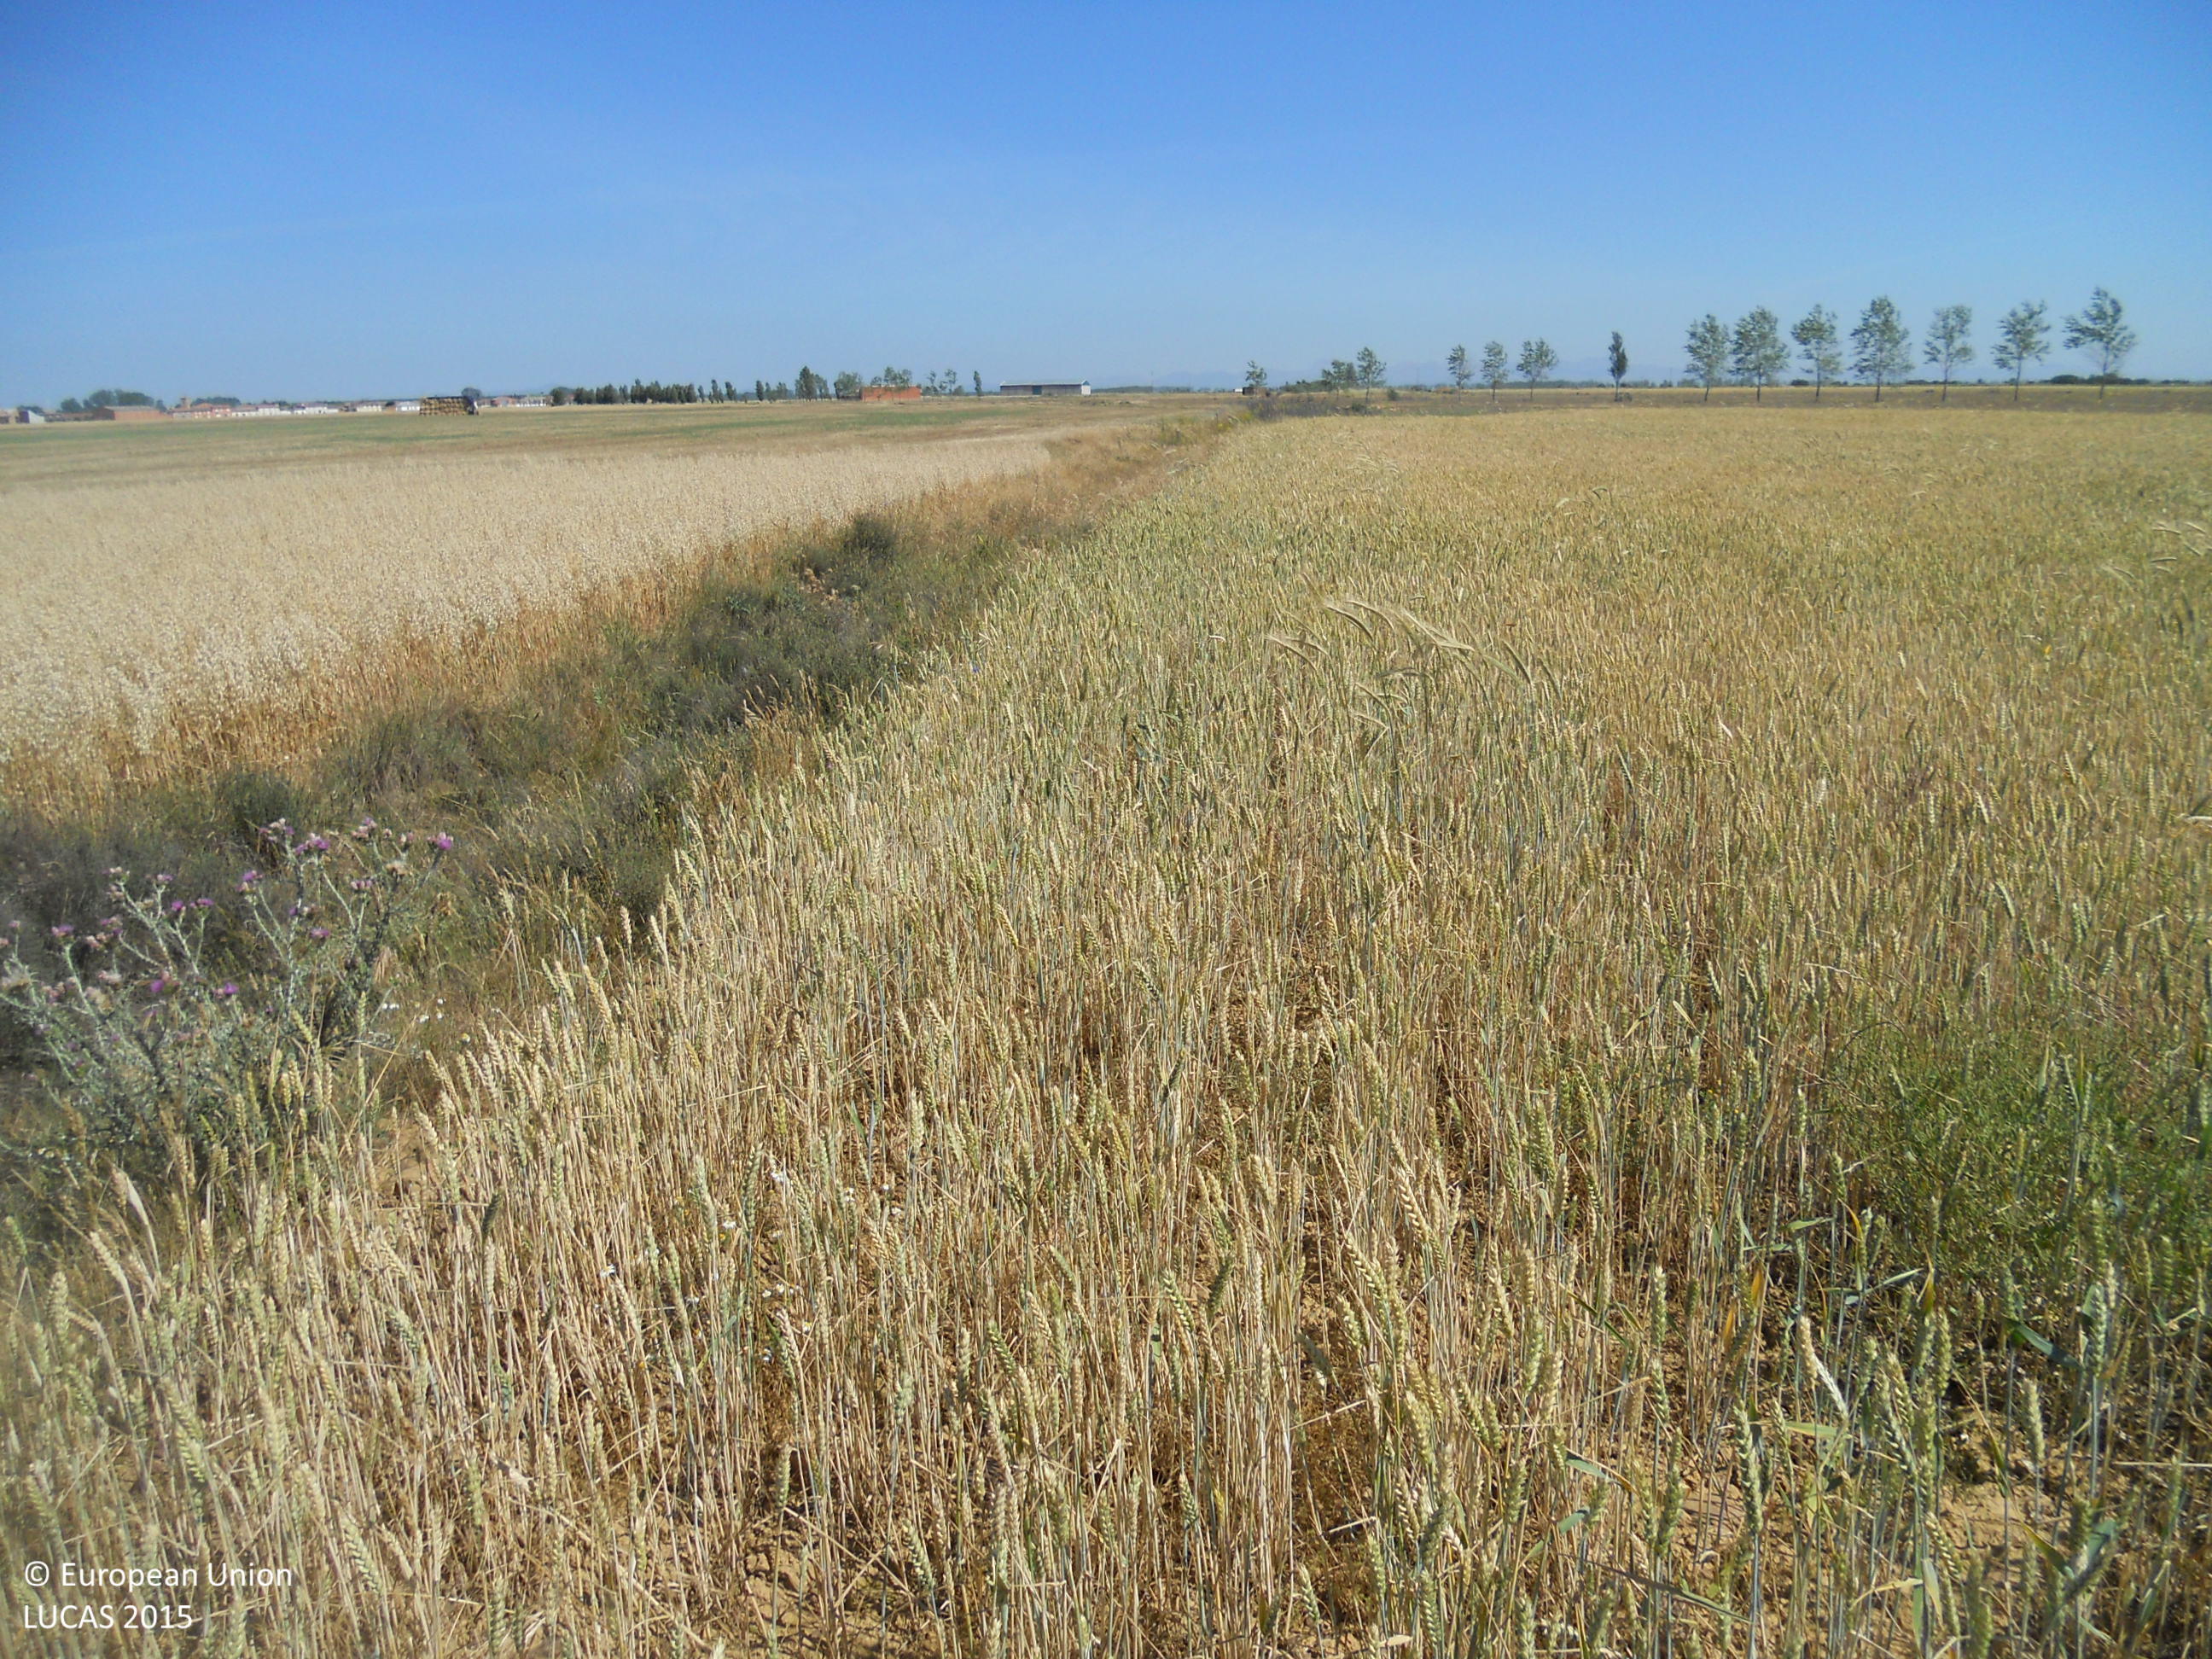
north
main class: Cropland
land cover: Common wheat
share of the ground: > 75 %
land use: Agriculture (excluding fallow land and kitchen gardens)
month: June
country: ES
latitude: 42.4005
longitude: -4.8170
